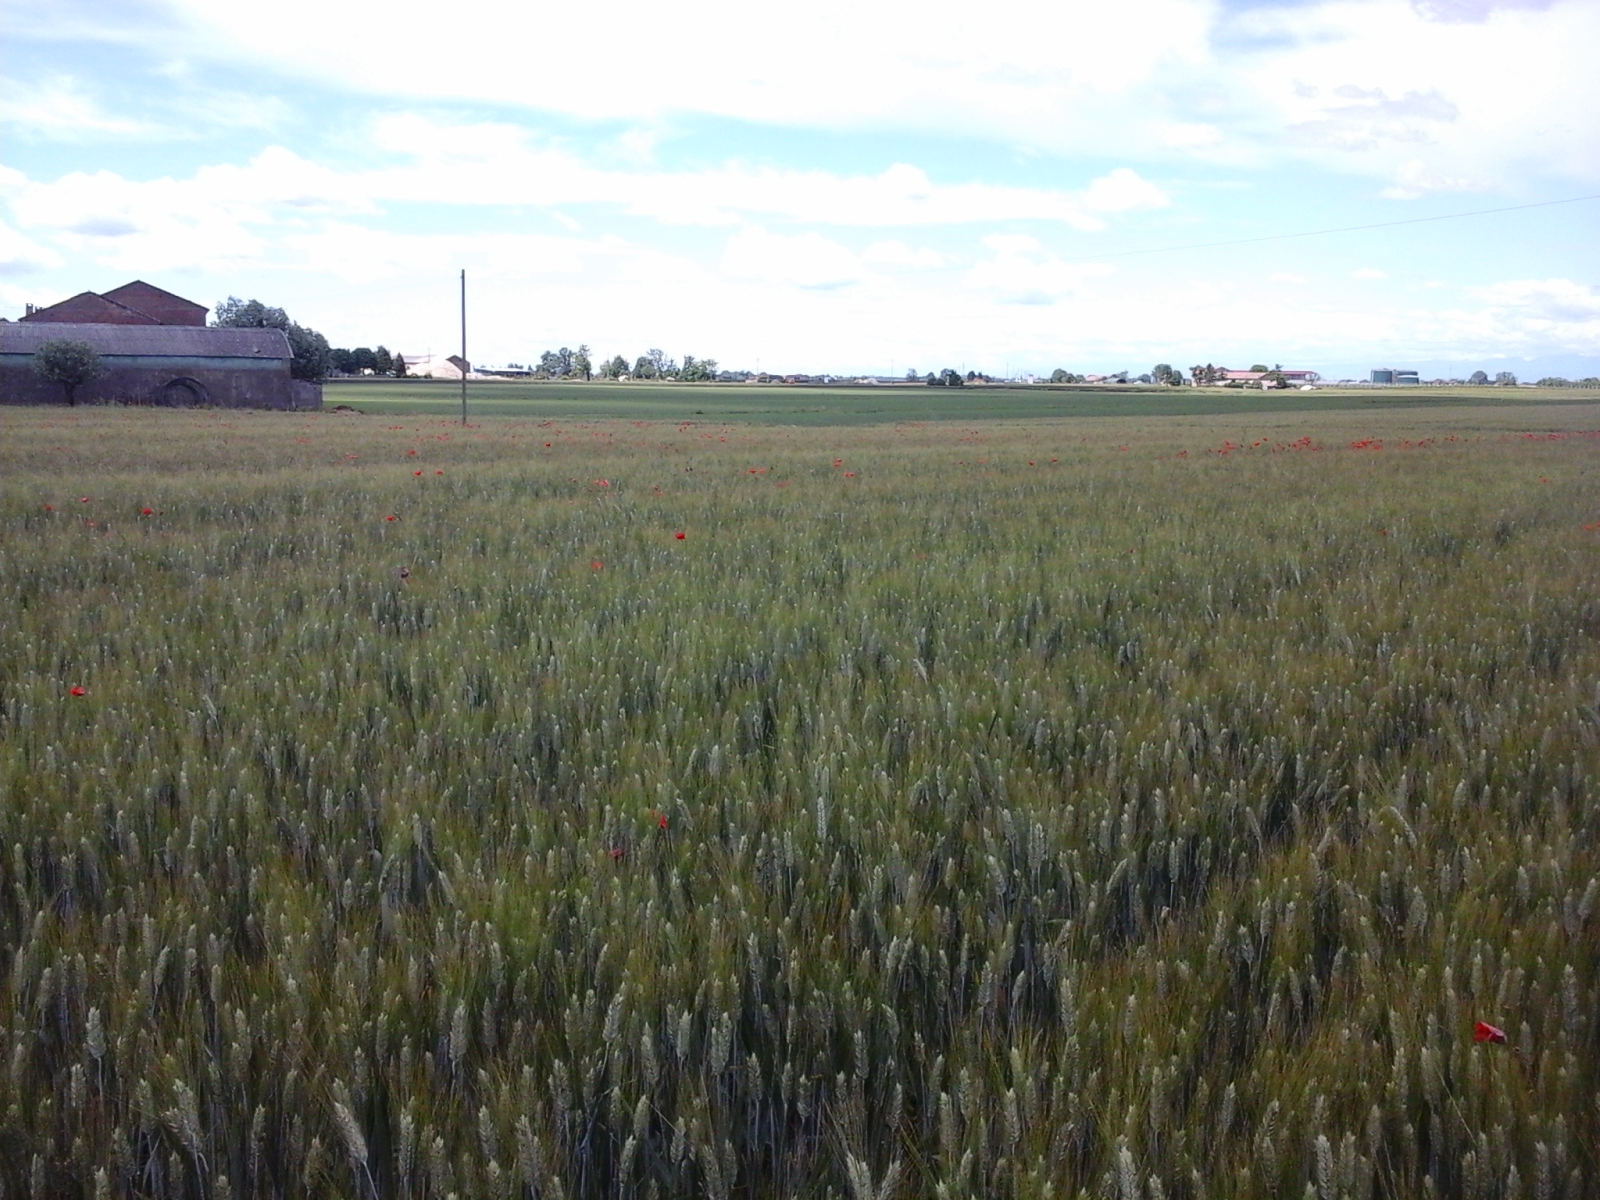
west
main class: Cropland
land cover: Durum wheat
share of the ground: > 75 %
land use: Agriculture (excluding fallow land and kitchen gardens)
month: May
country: IT
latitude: 45.0422
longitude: 11.5586
